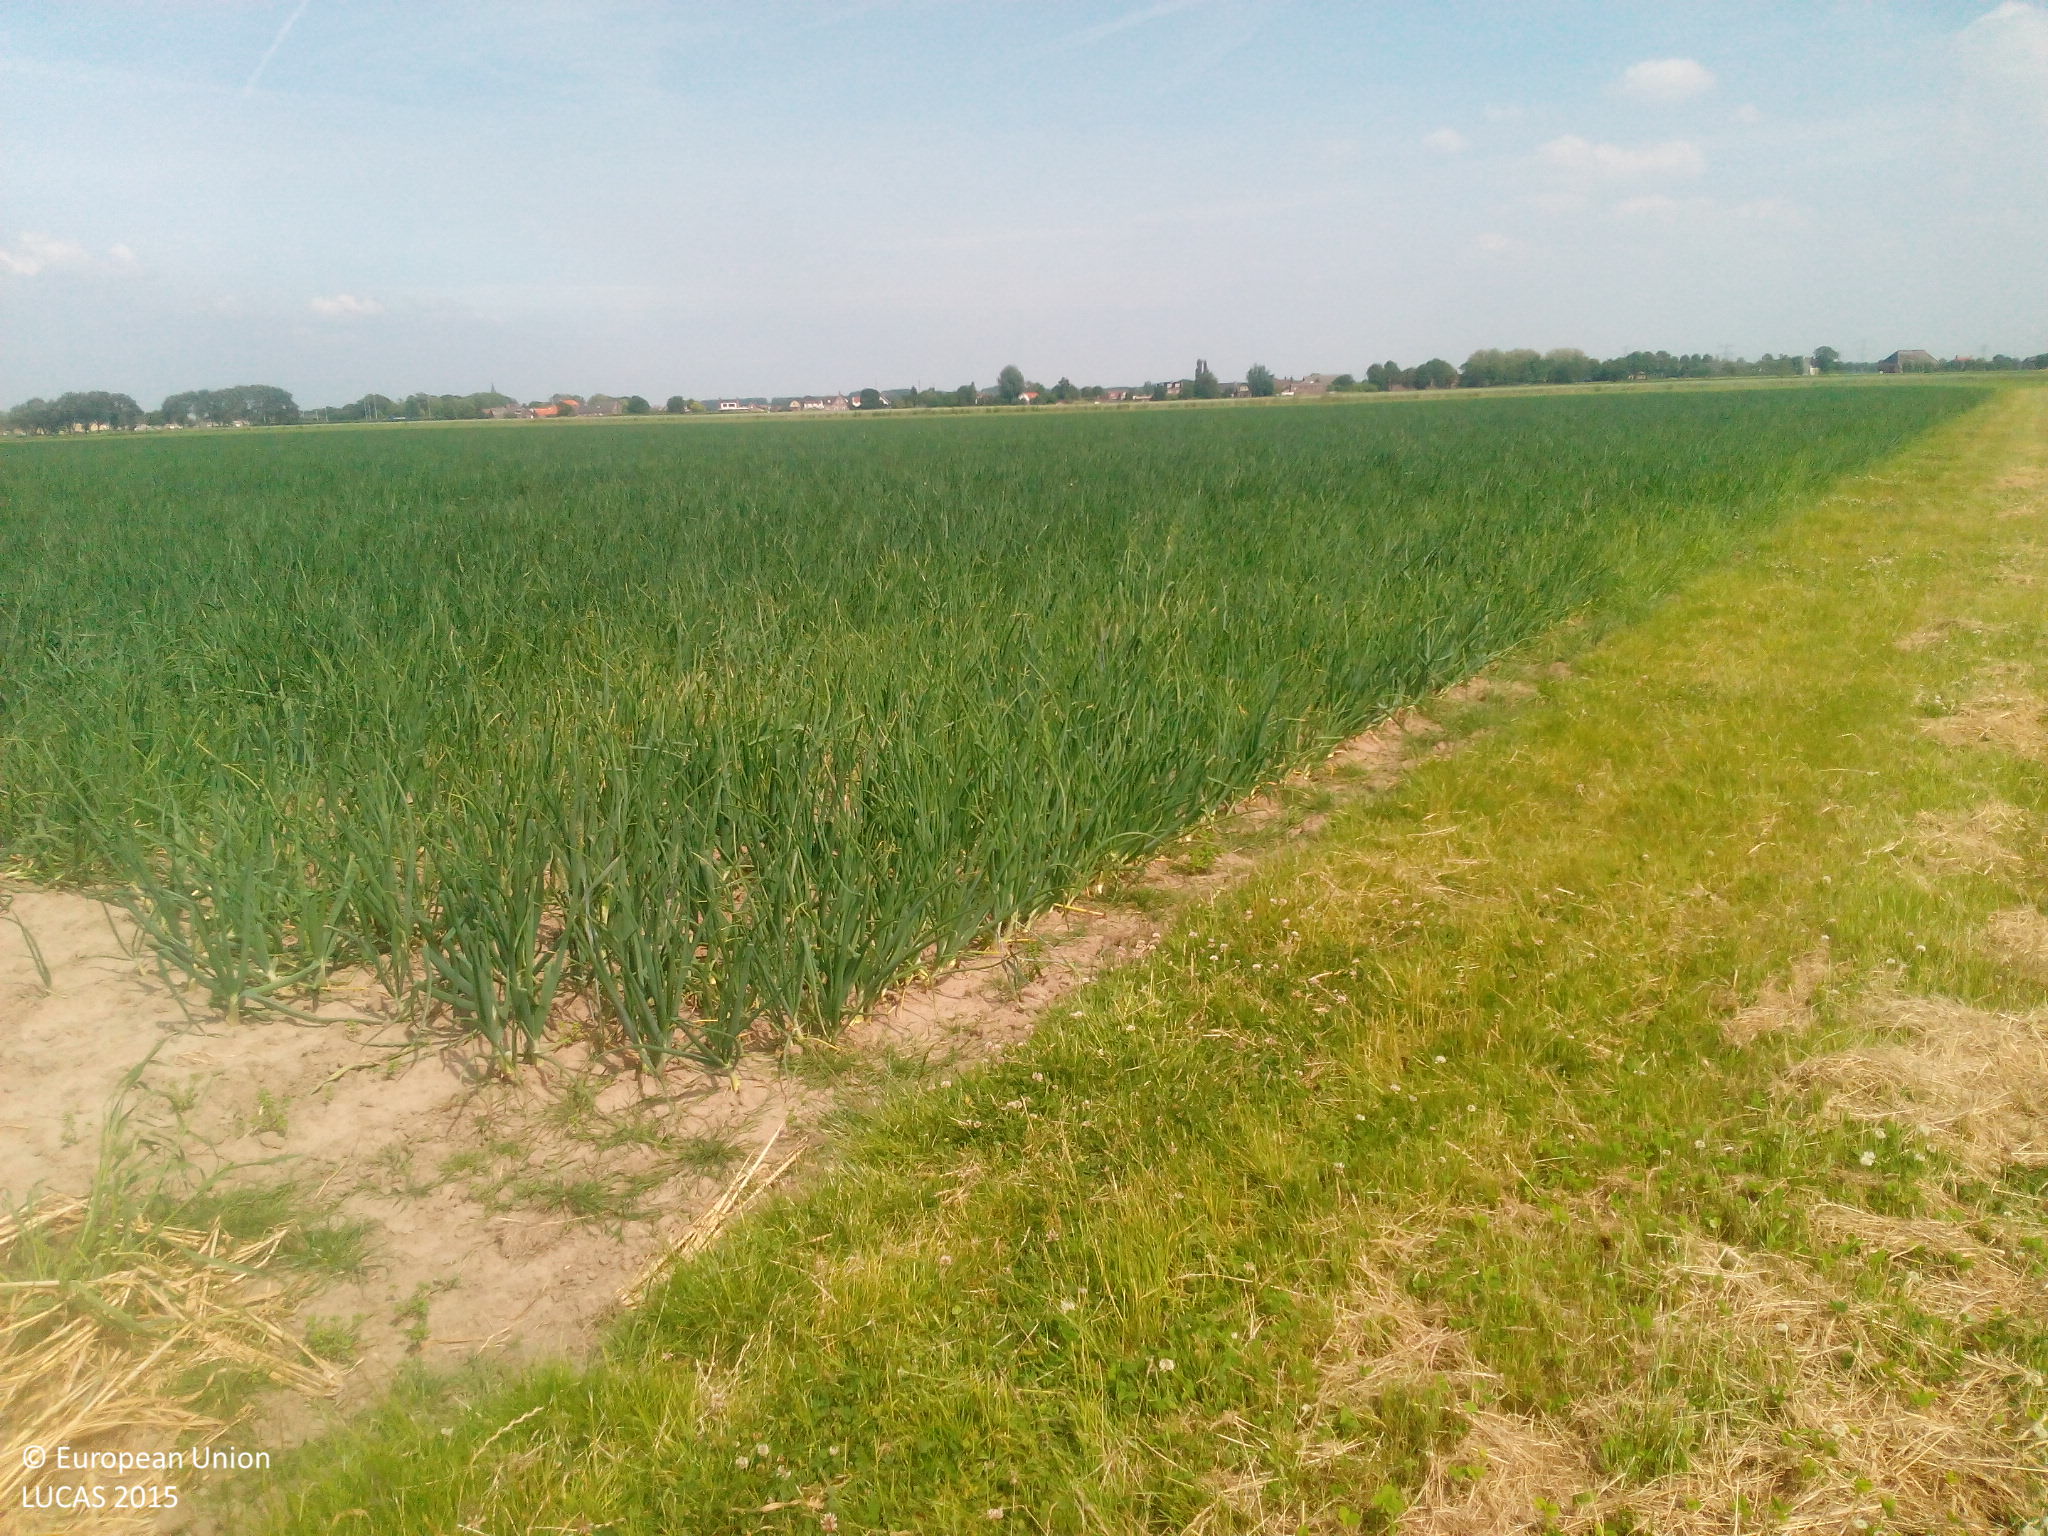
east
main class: Grassland
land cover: Grassland without tree/shrub cover
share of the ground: > 75 %
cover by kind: herbaceous plants 90 %, consolidated bare surface 10 %
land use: Agriculture (excluding fallow land and kitchen gardens)
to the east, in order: Ditches and canals; Grassland without tree/shrub cover; Other root crops; Maize
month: June
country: NL
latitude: 51.7001
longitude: 4.6862
